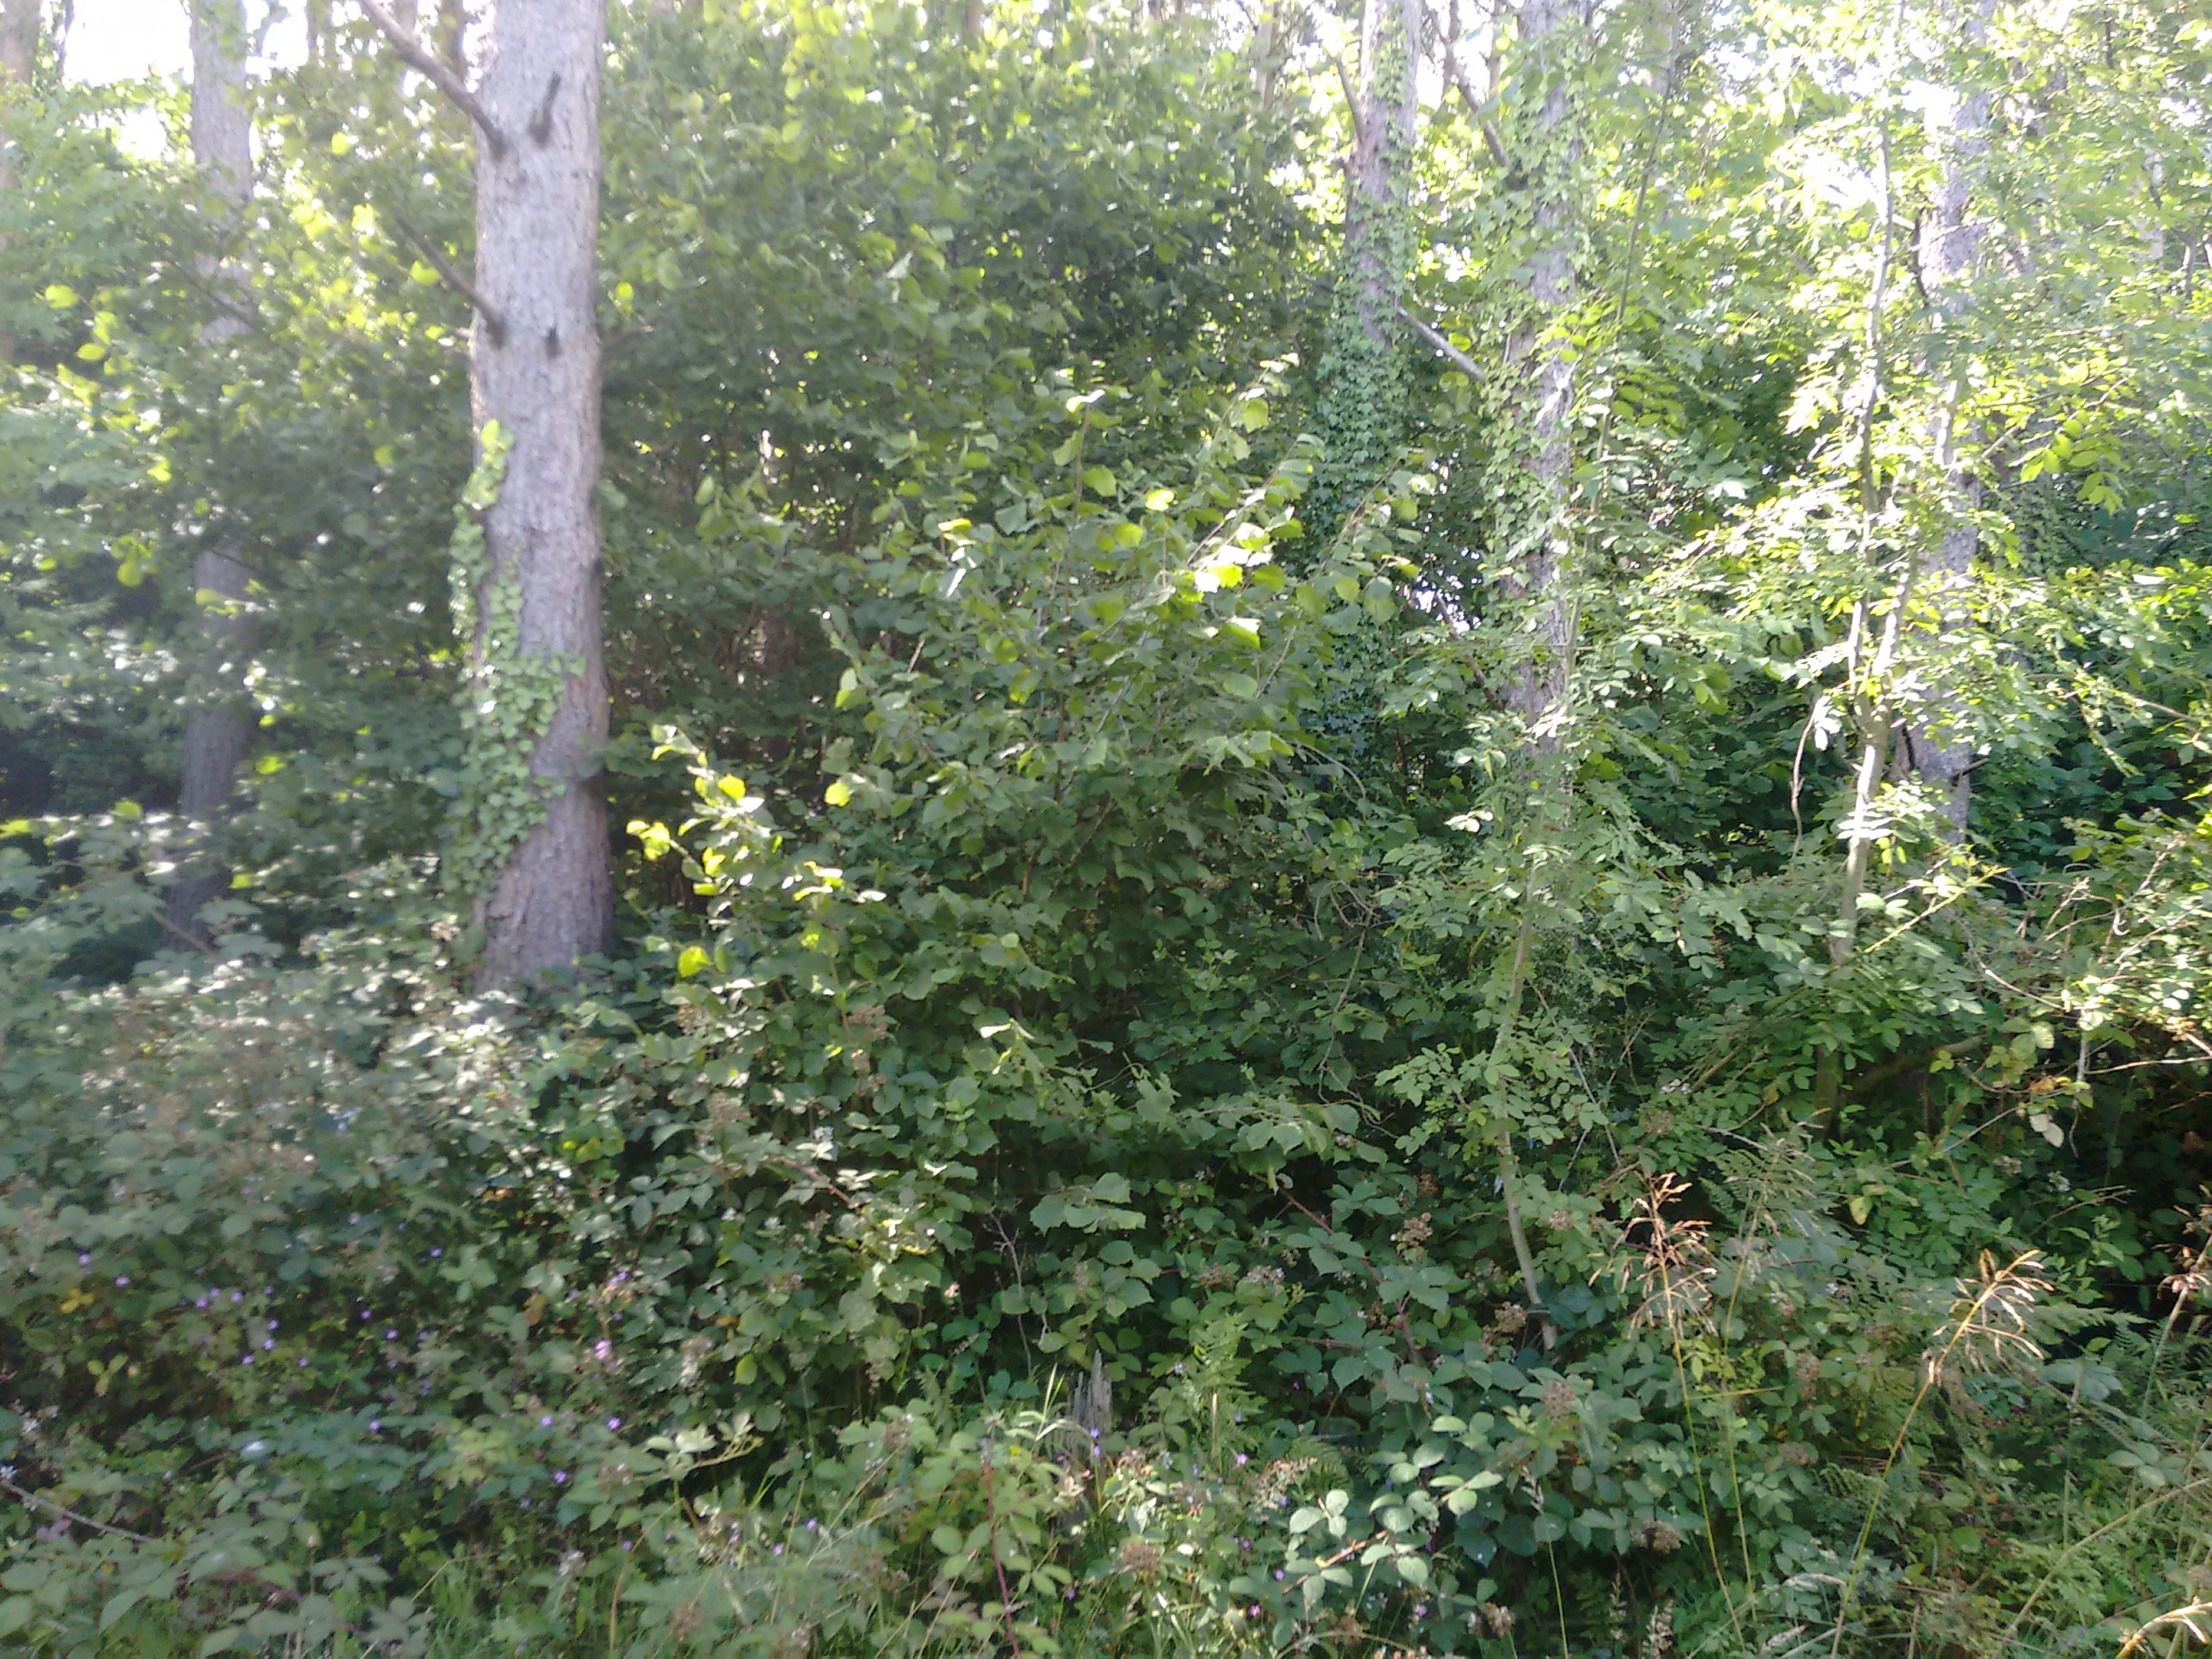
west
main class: Woodland
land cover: Other mixed woodland
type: exotic forest
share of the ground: > 75 %
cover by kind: coniferous forest trees 75 %, broadleaved forest trees 25 %
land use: Forestry
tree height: > 5 m
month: August
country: GB
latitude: 54.4764
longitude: -6.8164
